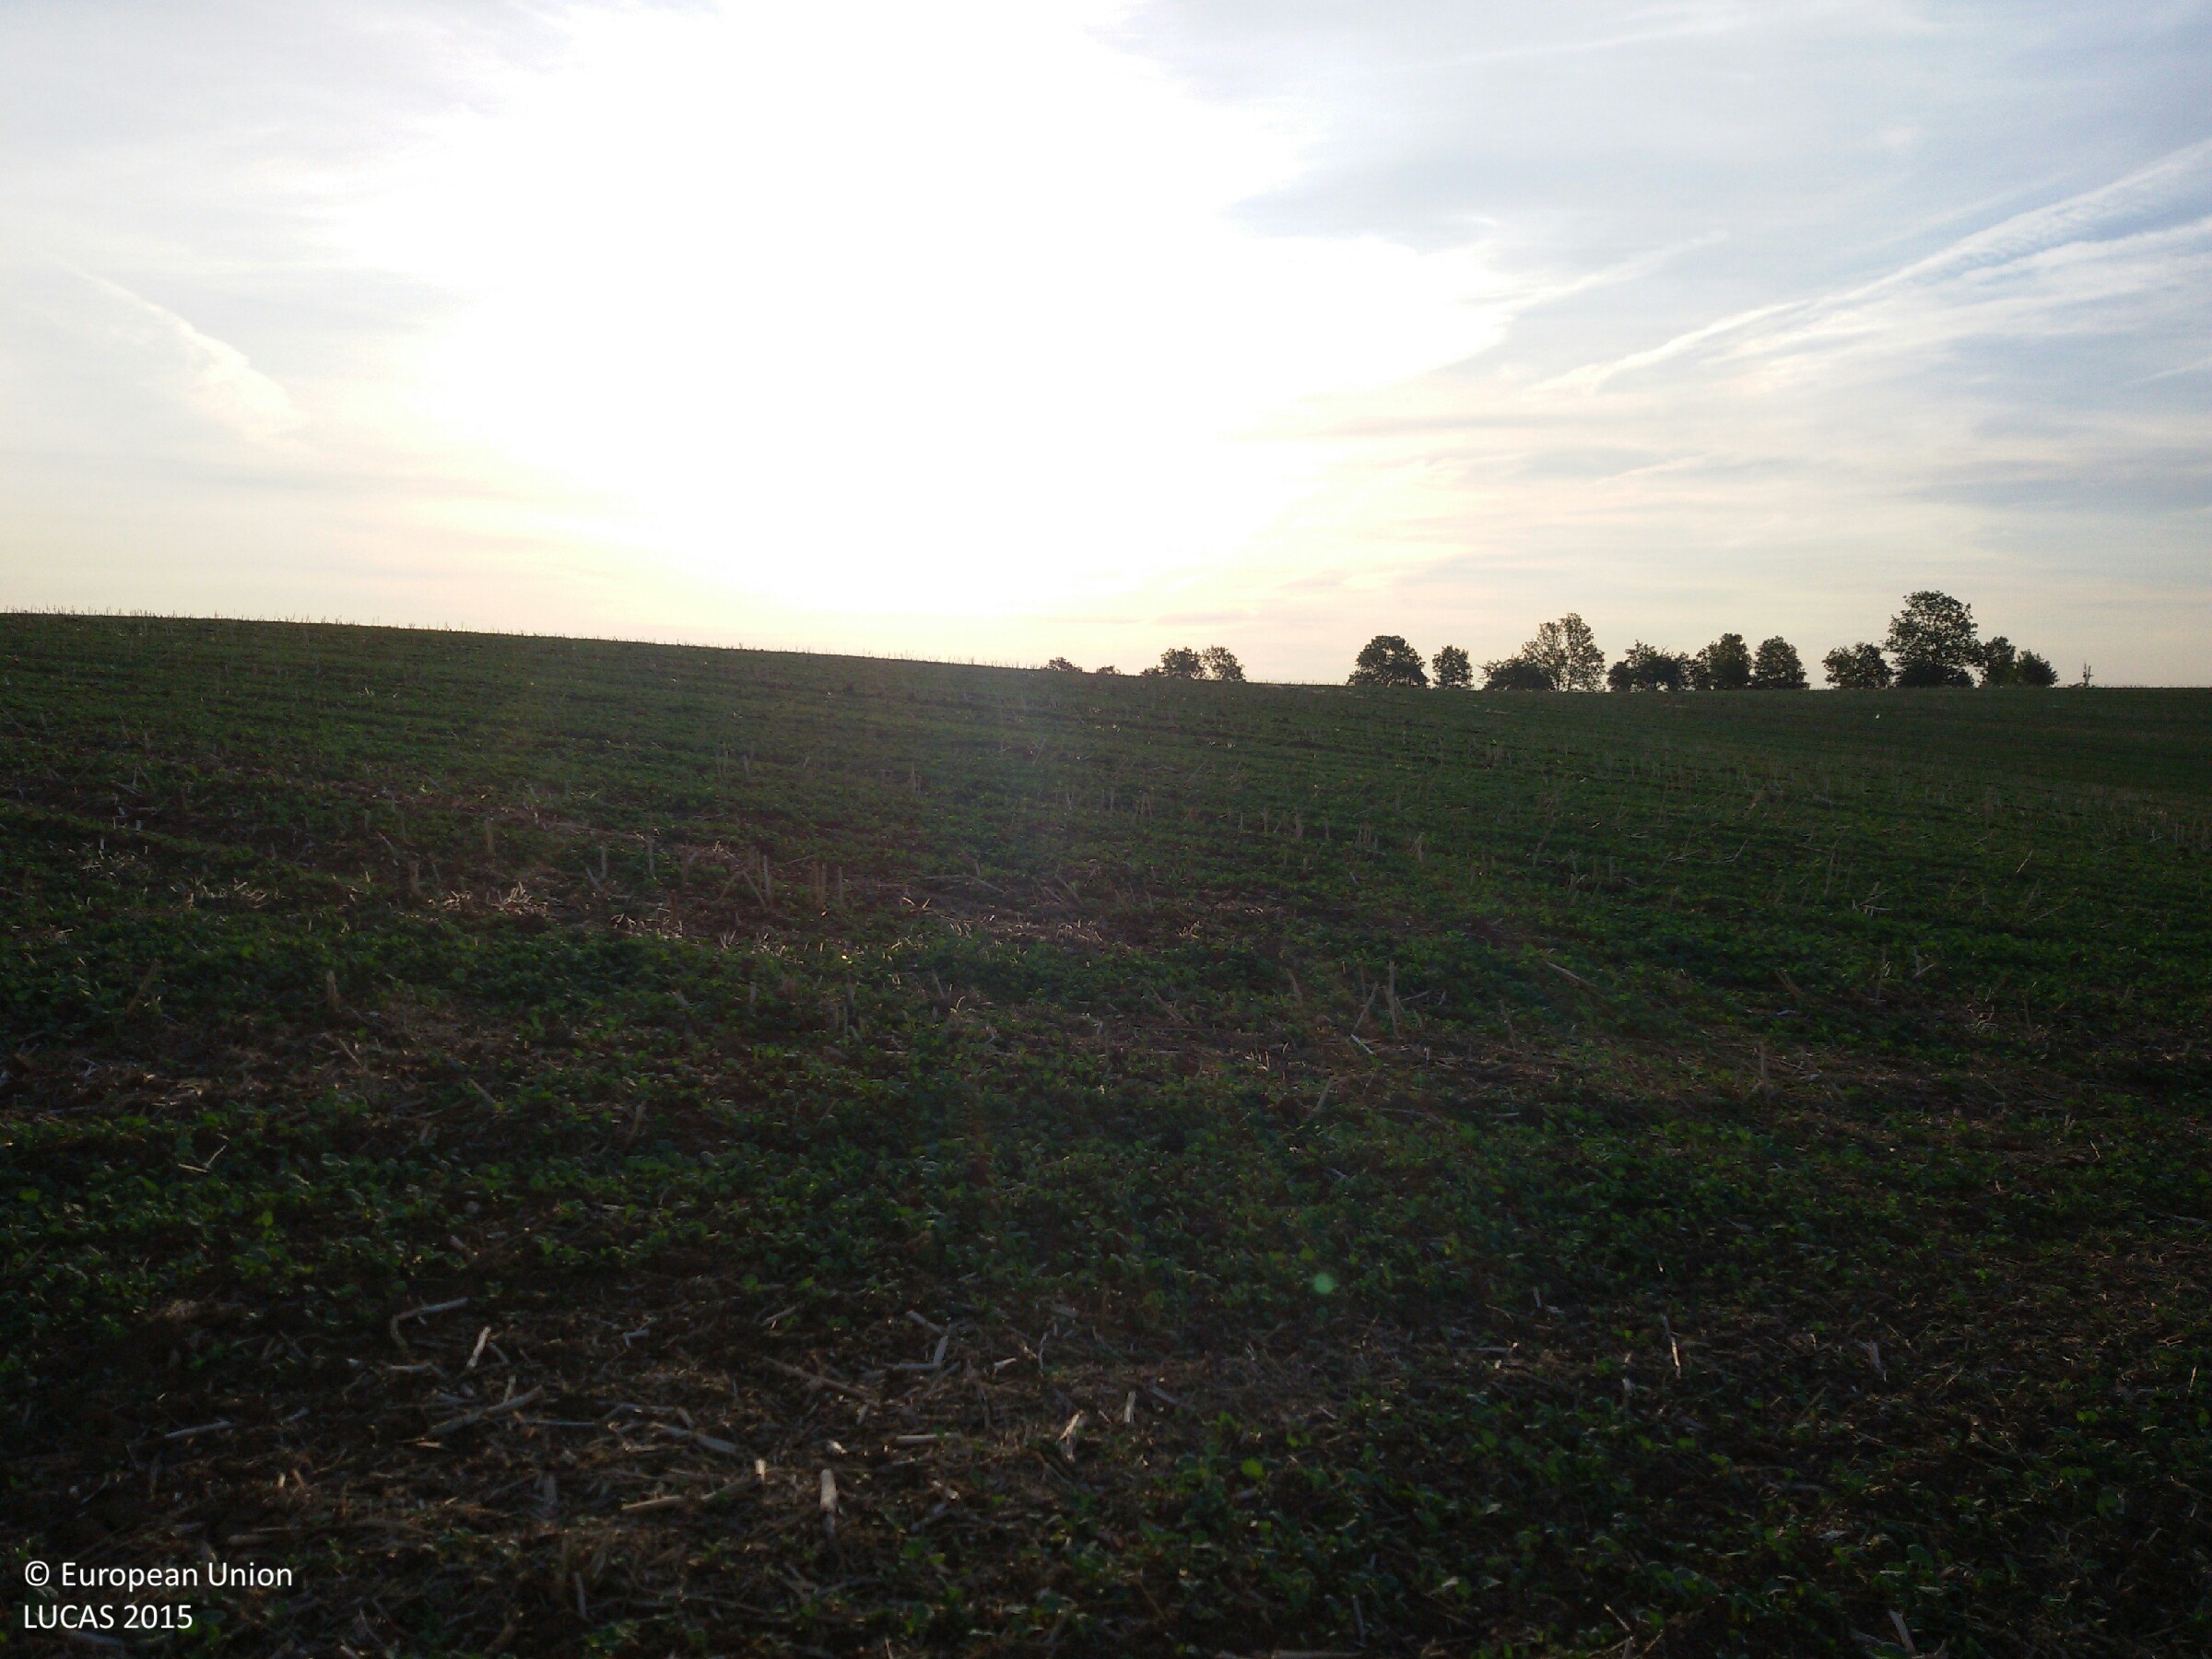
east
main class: Cropland
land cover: Rape and turnip rape
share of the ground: 25 - 50 %
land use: Agriculture (excluding fallow land and kitchen gardens)
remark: Harvested field
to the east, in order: Tracks; Rape and turnip rape
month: August
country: PL
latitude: 53.9459
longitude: 19.3337
